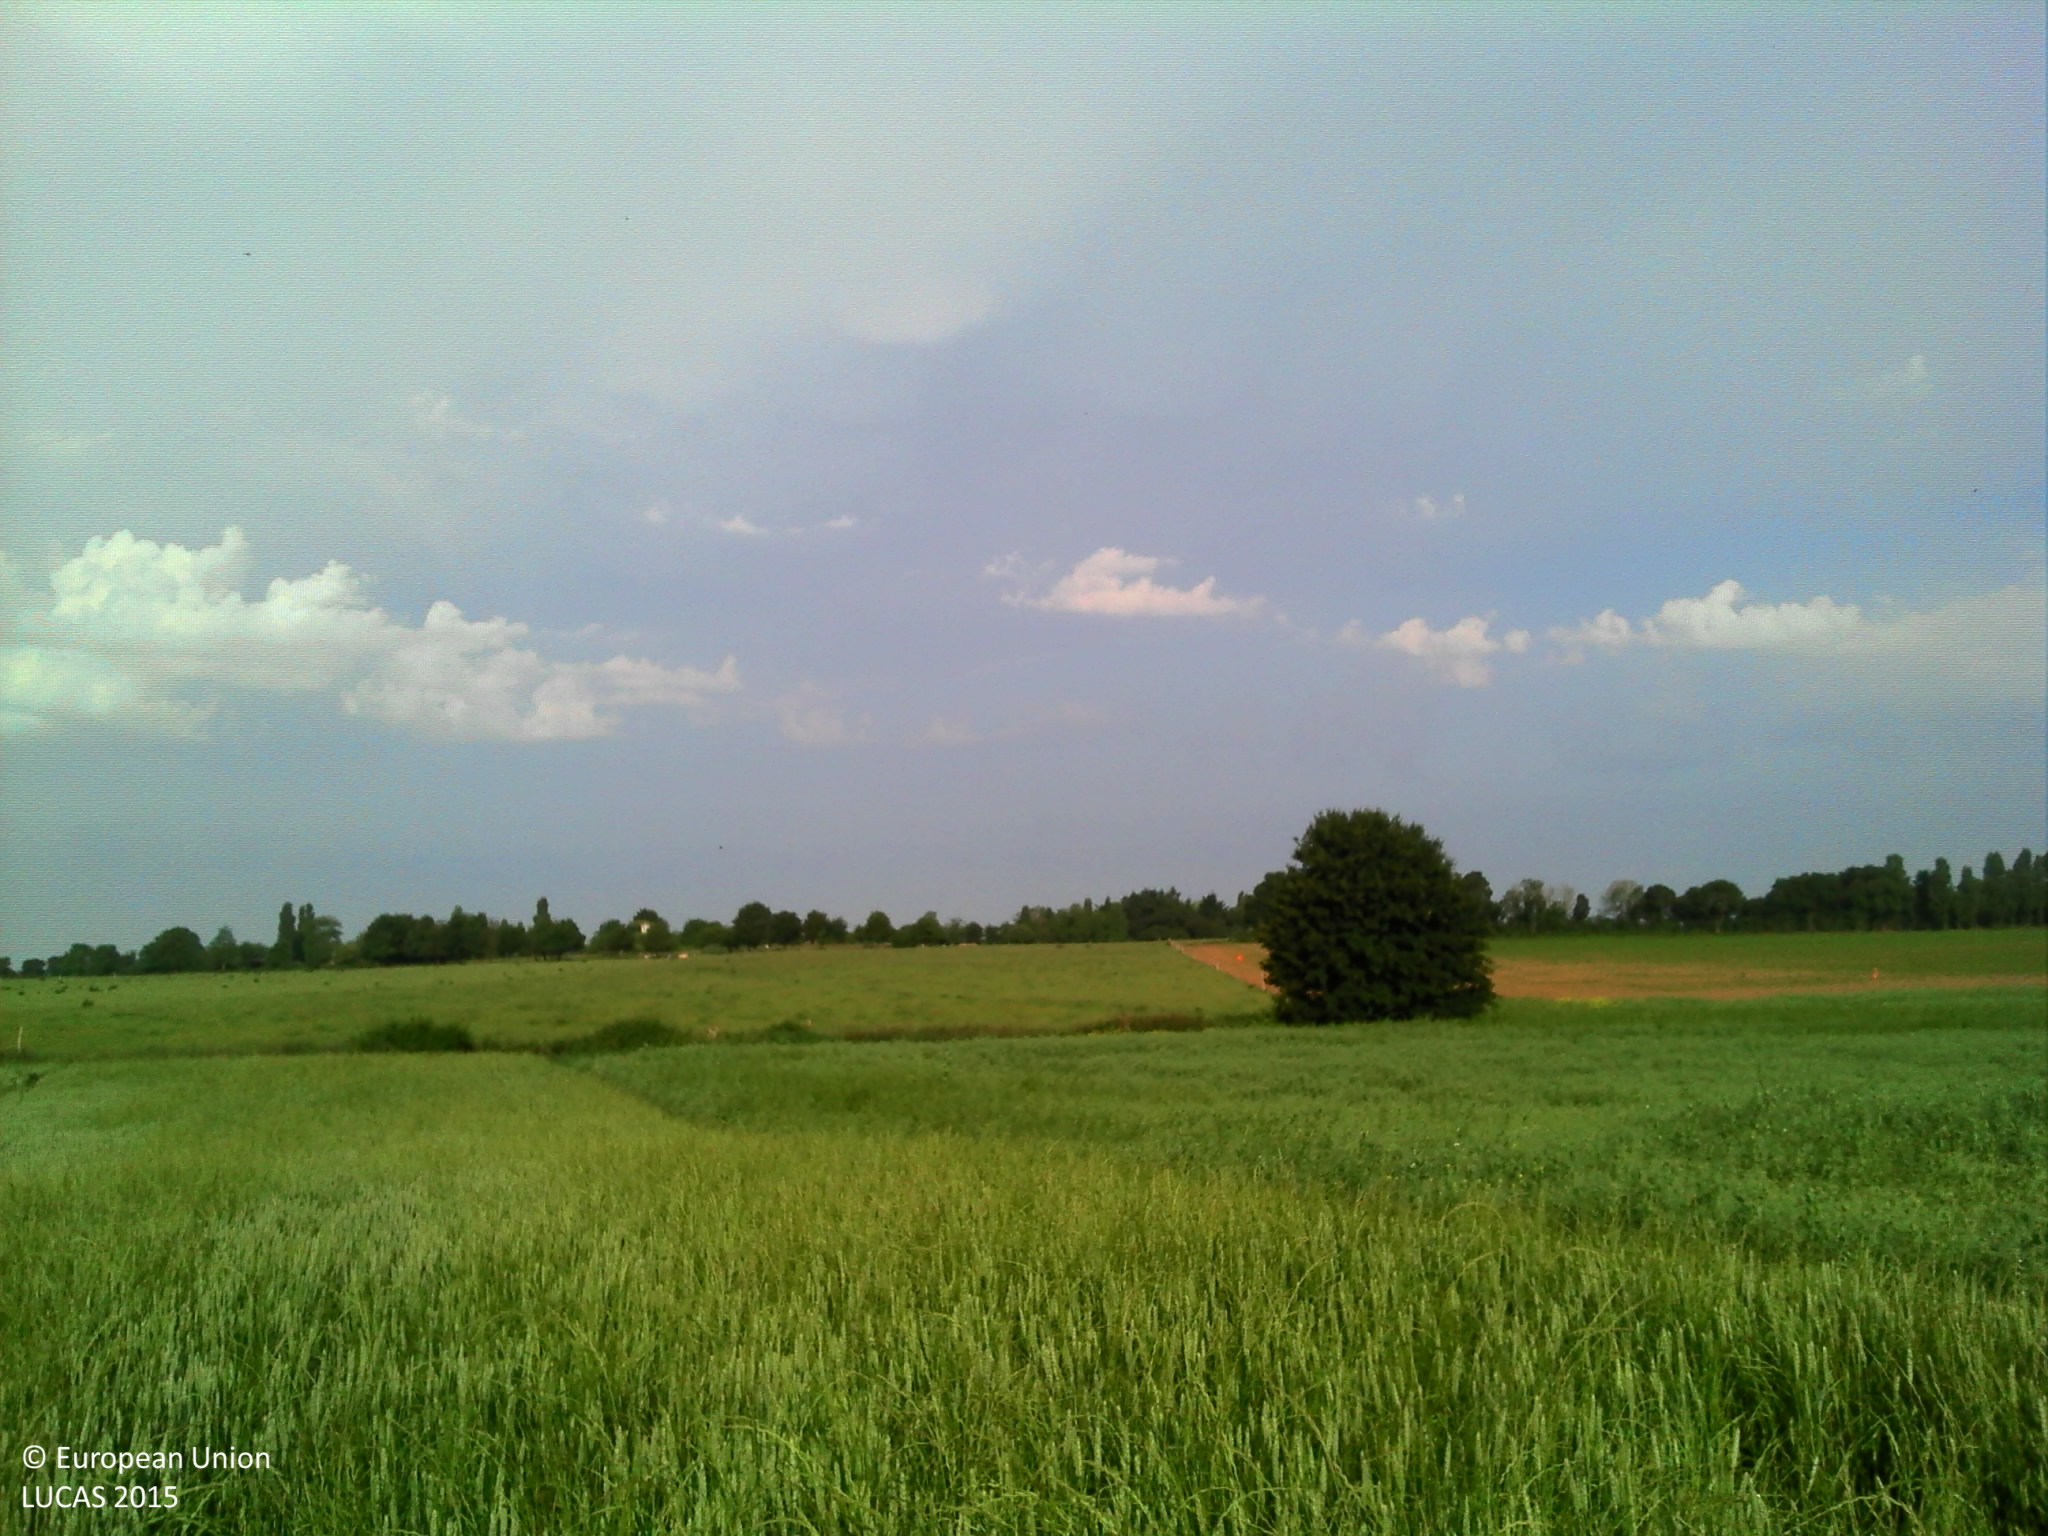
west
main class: Cropland
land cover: Mixed cereals for fodder
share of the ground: > 75 %
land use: Agriculture (excluding fallow land and kitchen gardens)
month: June
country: FR
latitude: 47.9464
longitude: -0.0294
